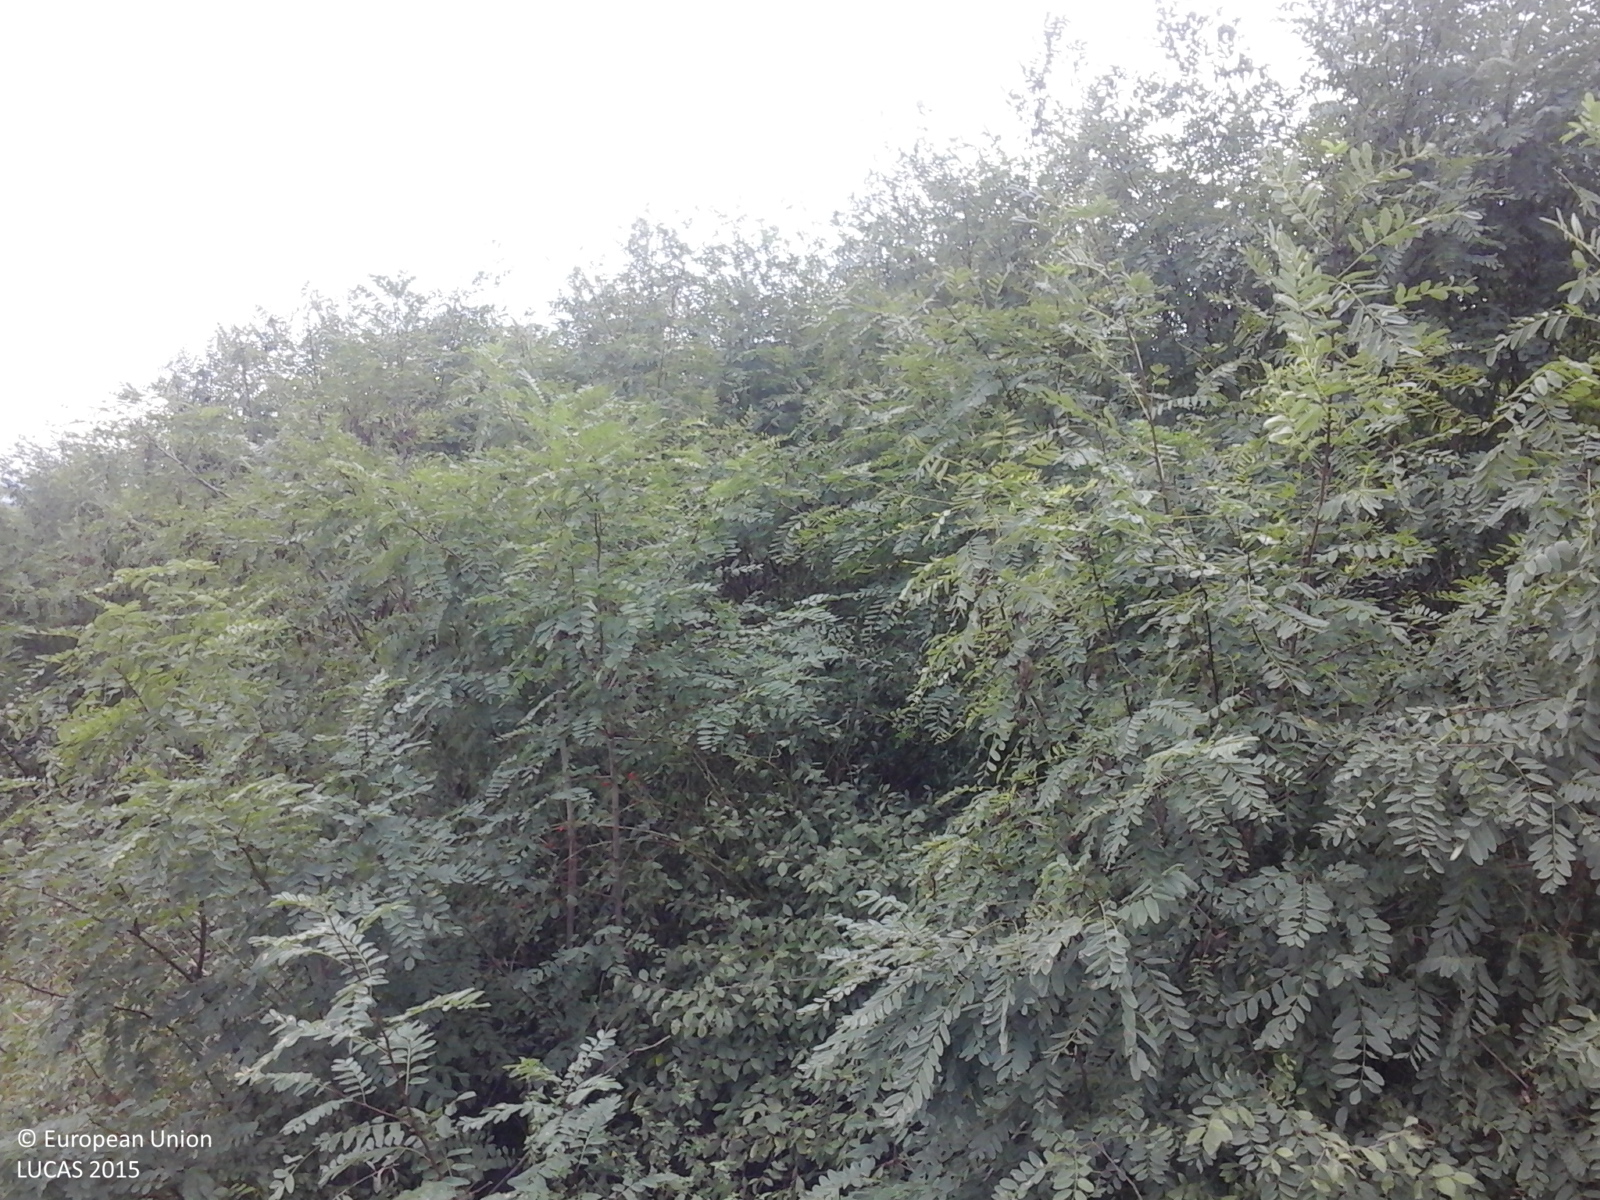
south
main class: Cropland
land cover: Maize
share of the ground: > 75 %
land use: Agriculture (excluding fallow land and kitchen gardens)
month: September
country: RO
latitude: 45.9536
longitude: 23.7311
